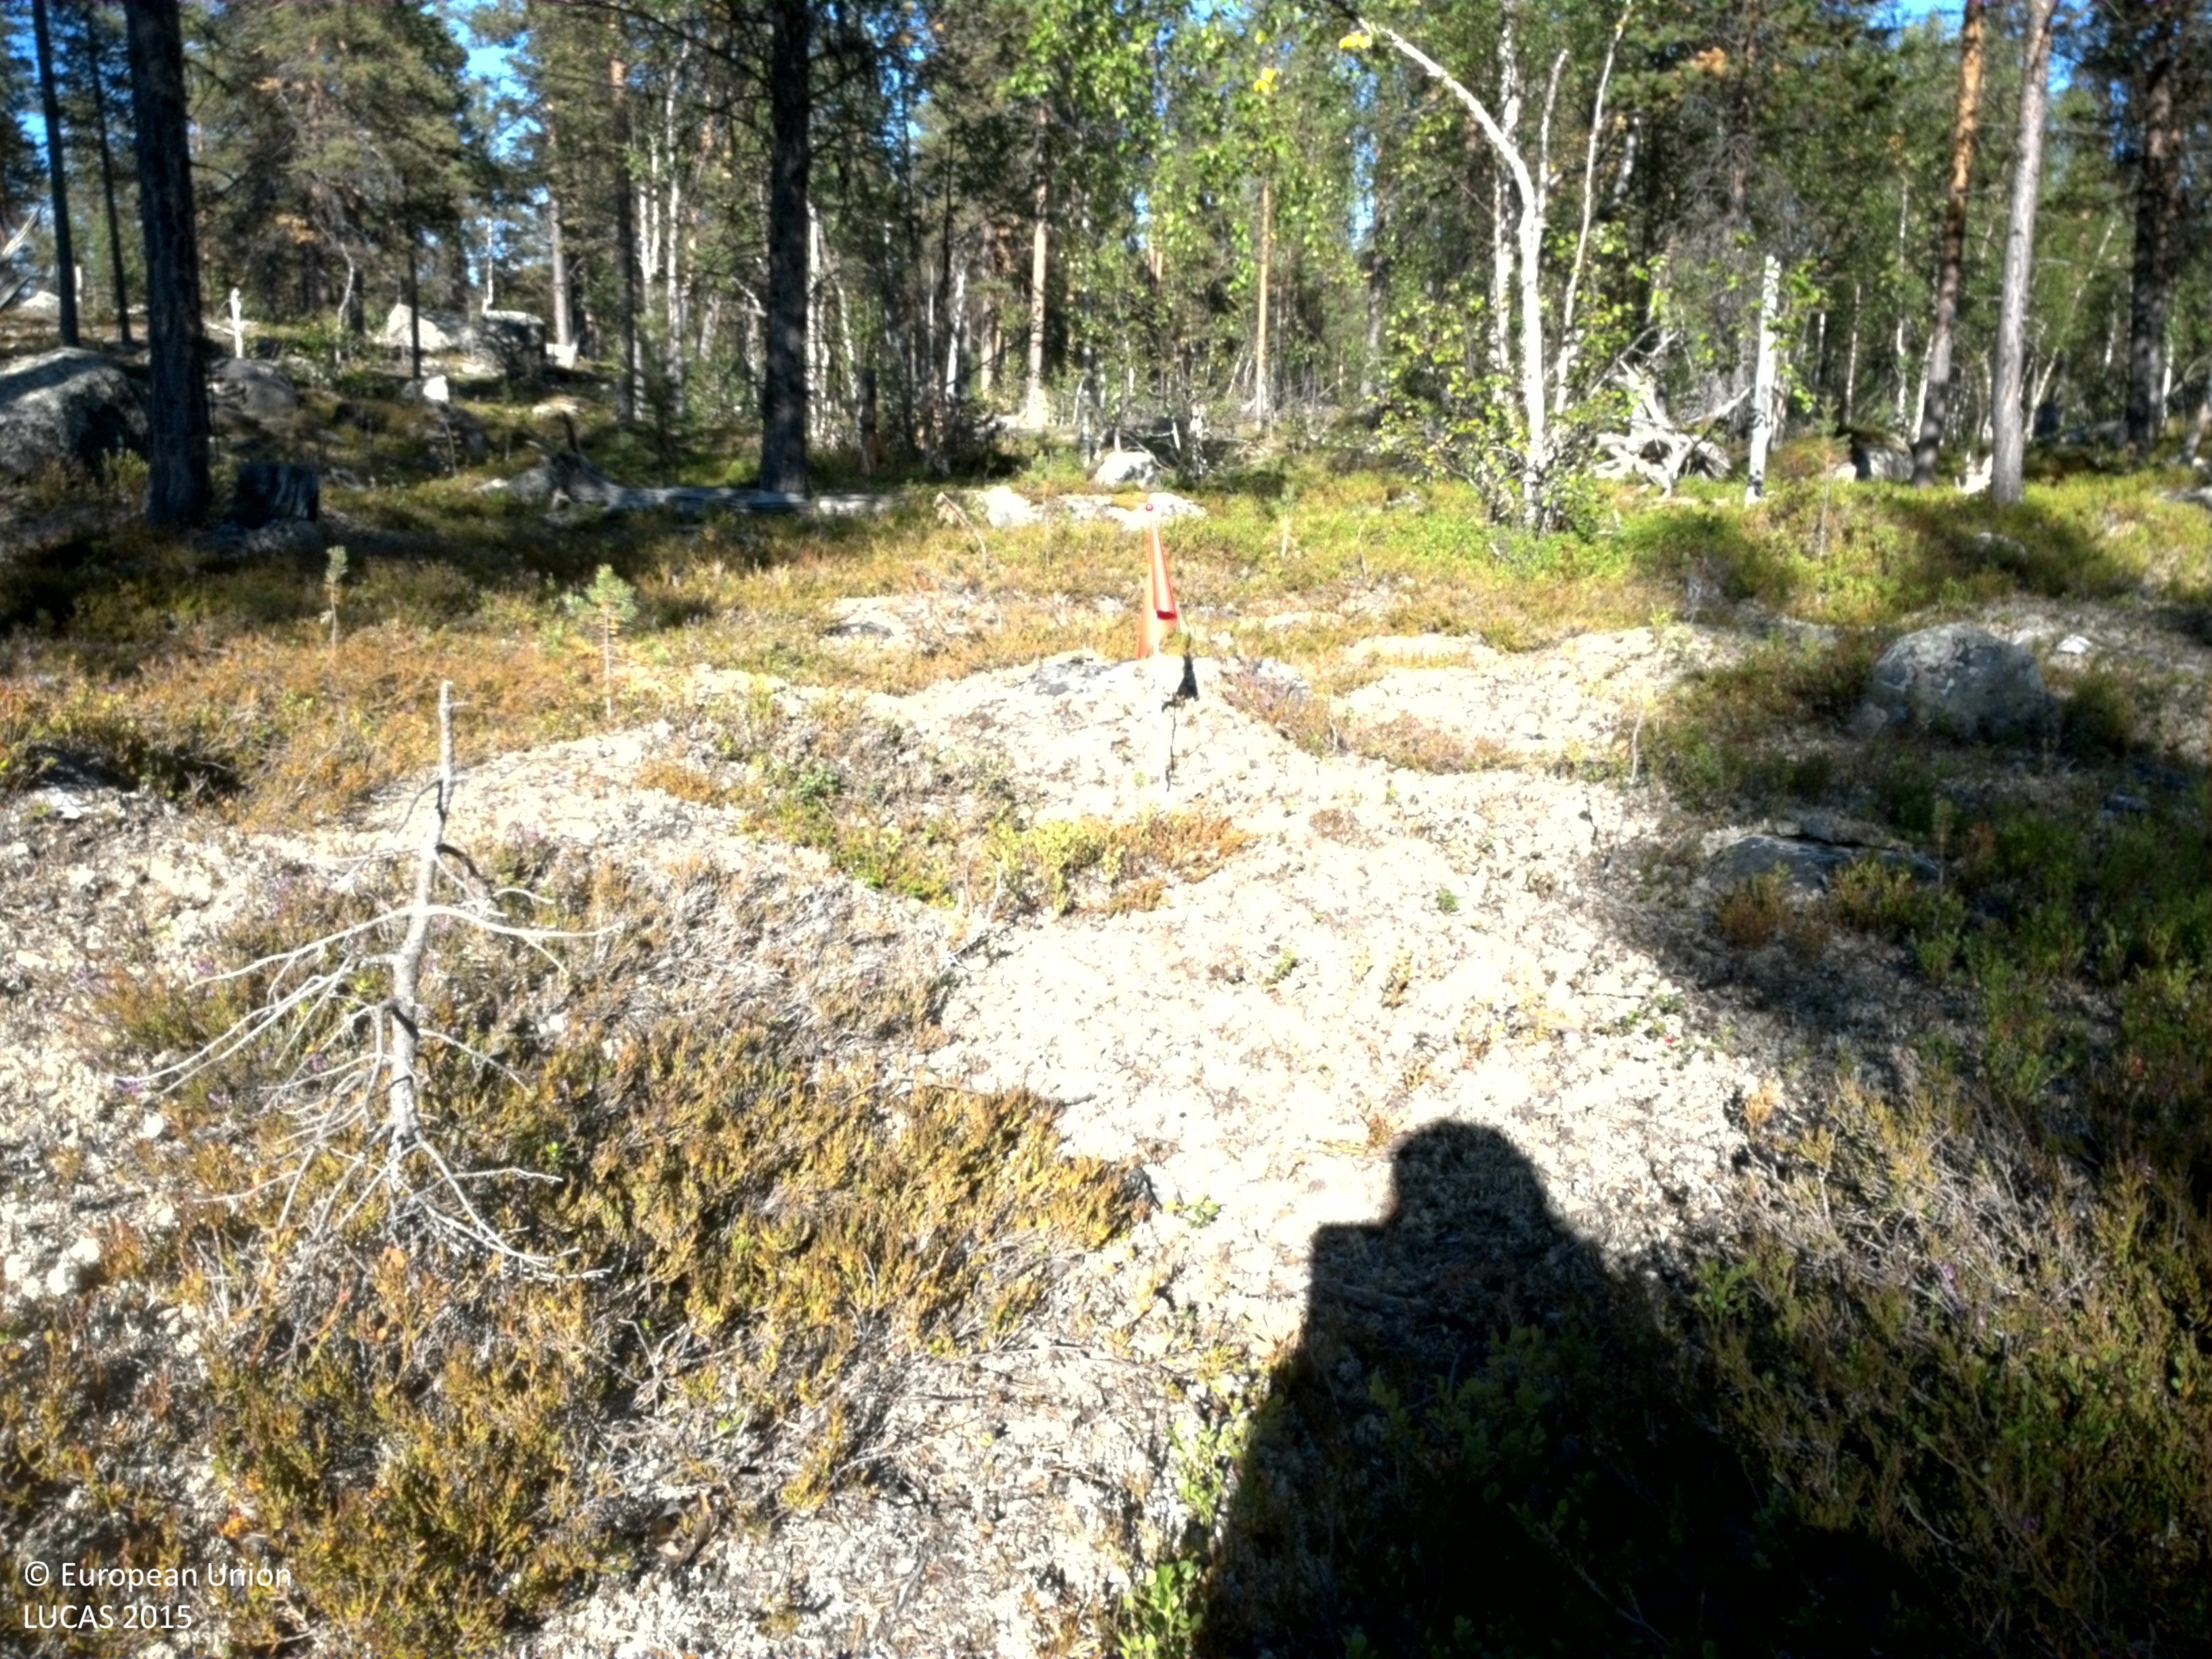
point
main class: Woodland
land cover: Pine dominated mixed woodland
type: boreal forest
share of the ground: 25 - 50 %
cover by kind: shrubs 50 %, coniferous forest trees 15 %, lichens and mosses 15 %, broadleaved forest trees 10 %, consolidated bare surface 10 %
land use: Forestry
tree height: > 5 m
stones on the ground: 25 - 50 %
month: August
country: SE
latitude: 66.6957
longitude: 18.9423
